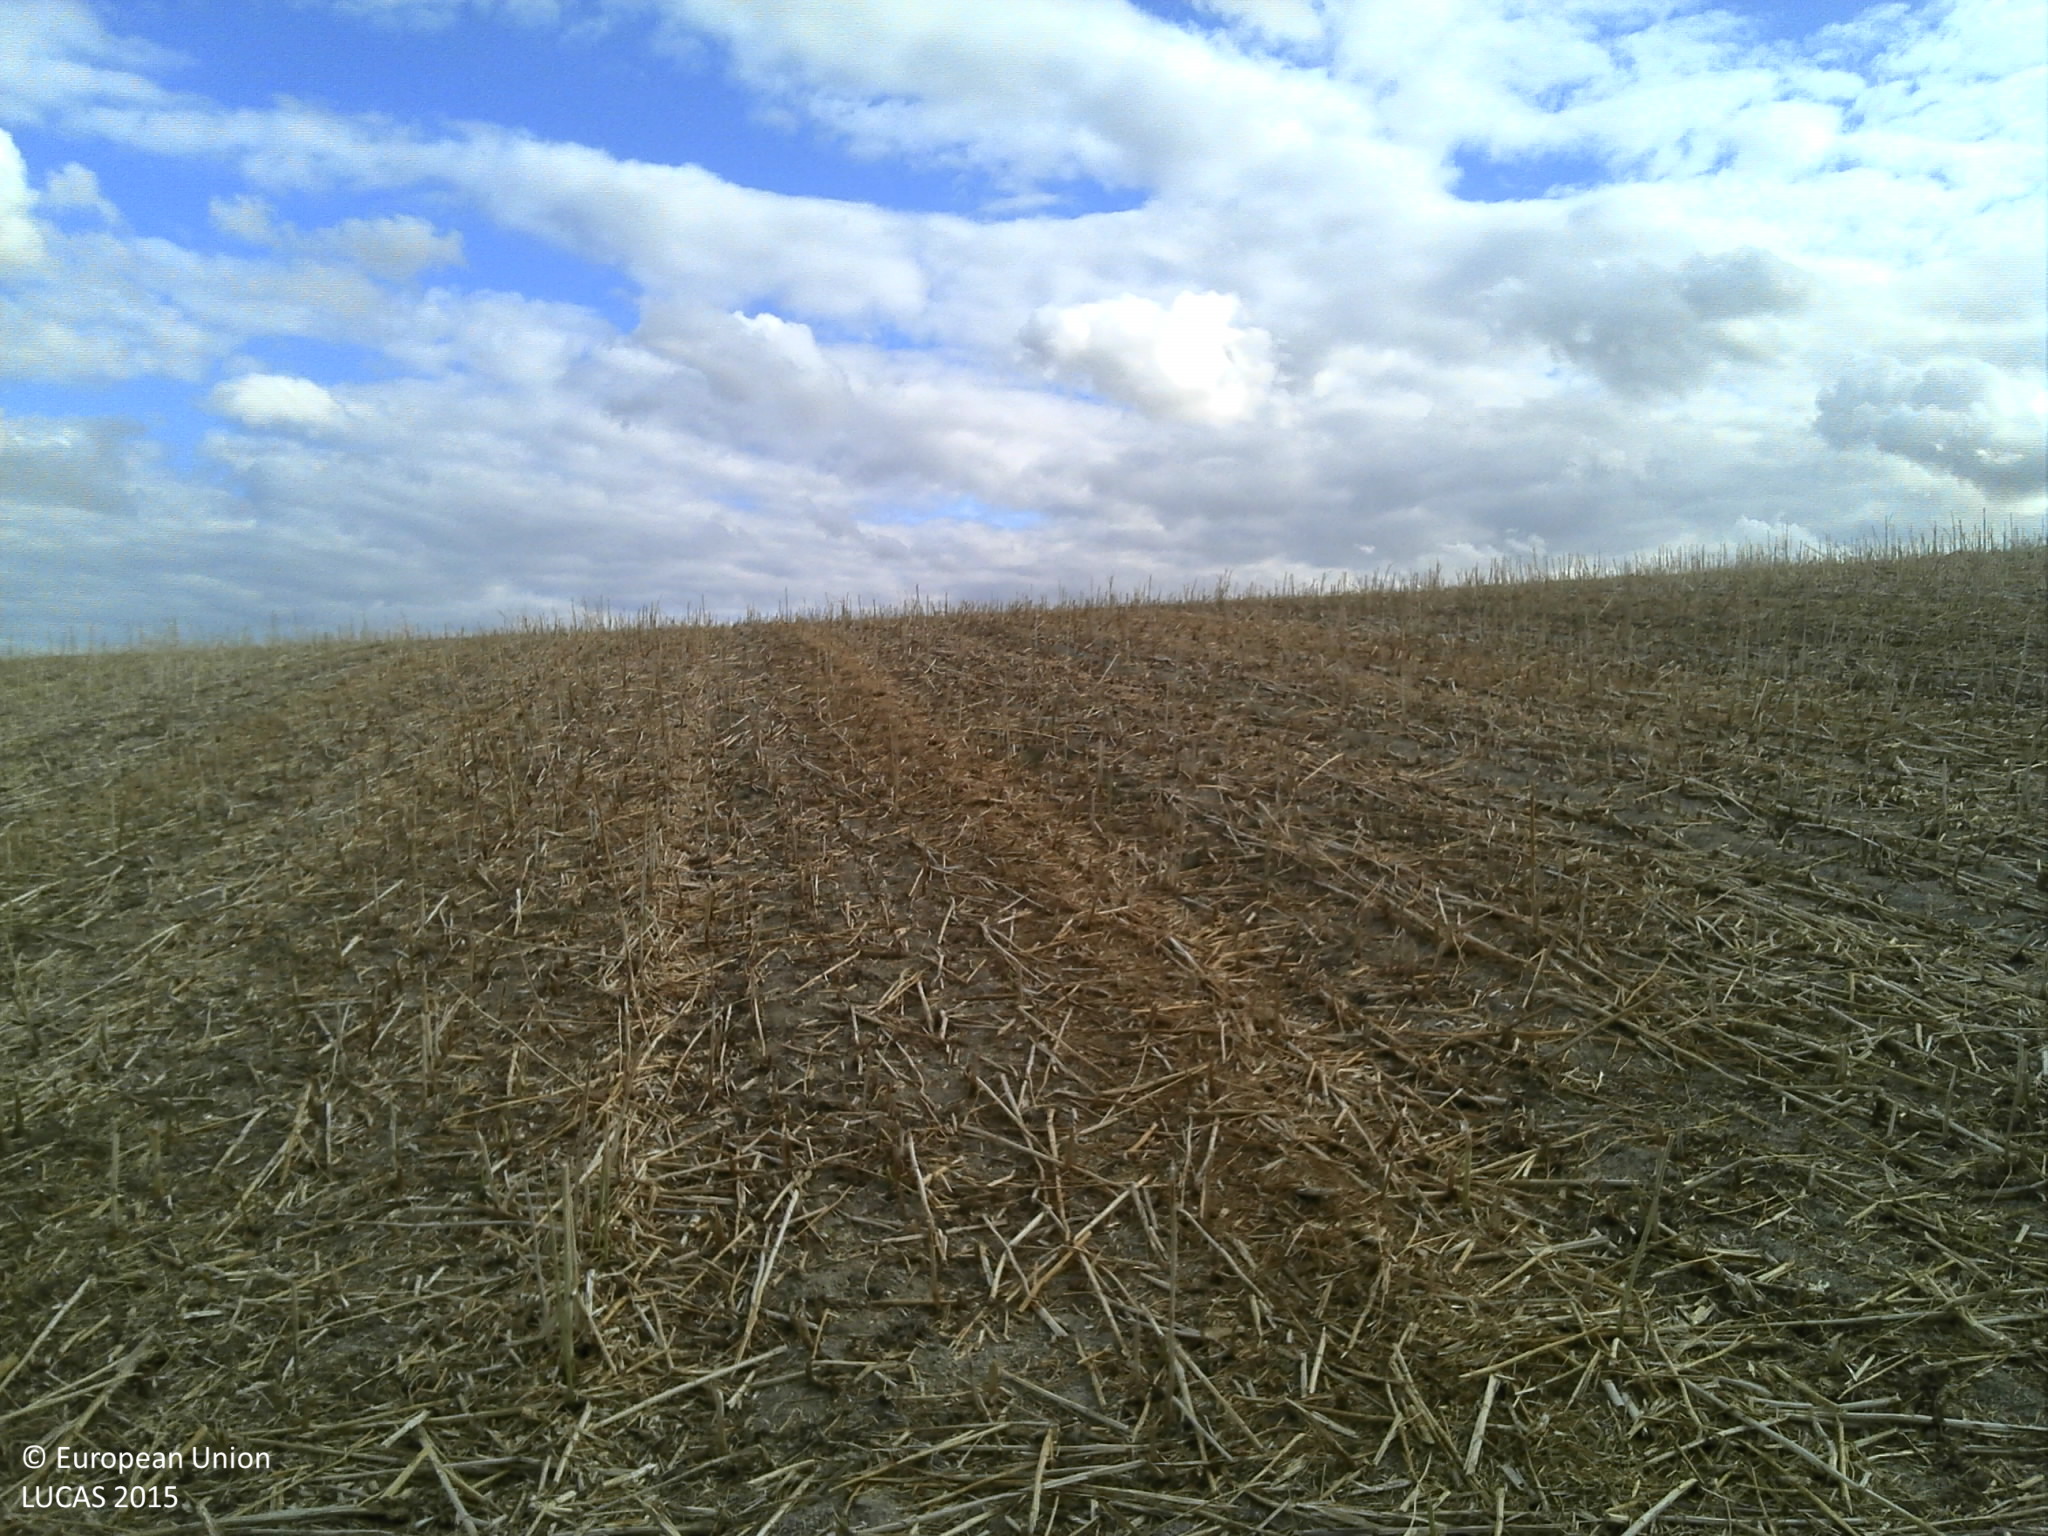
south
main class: Cropland
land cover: Rape and turnip rape
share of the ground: 25 - 50 %
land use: Agriculture (excluding fallow land and kitchen gardens)
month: July
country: FR
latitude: 49.4563
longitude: 4.4918
